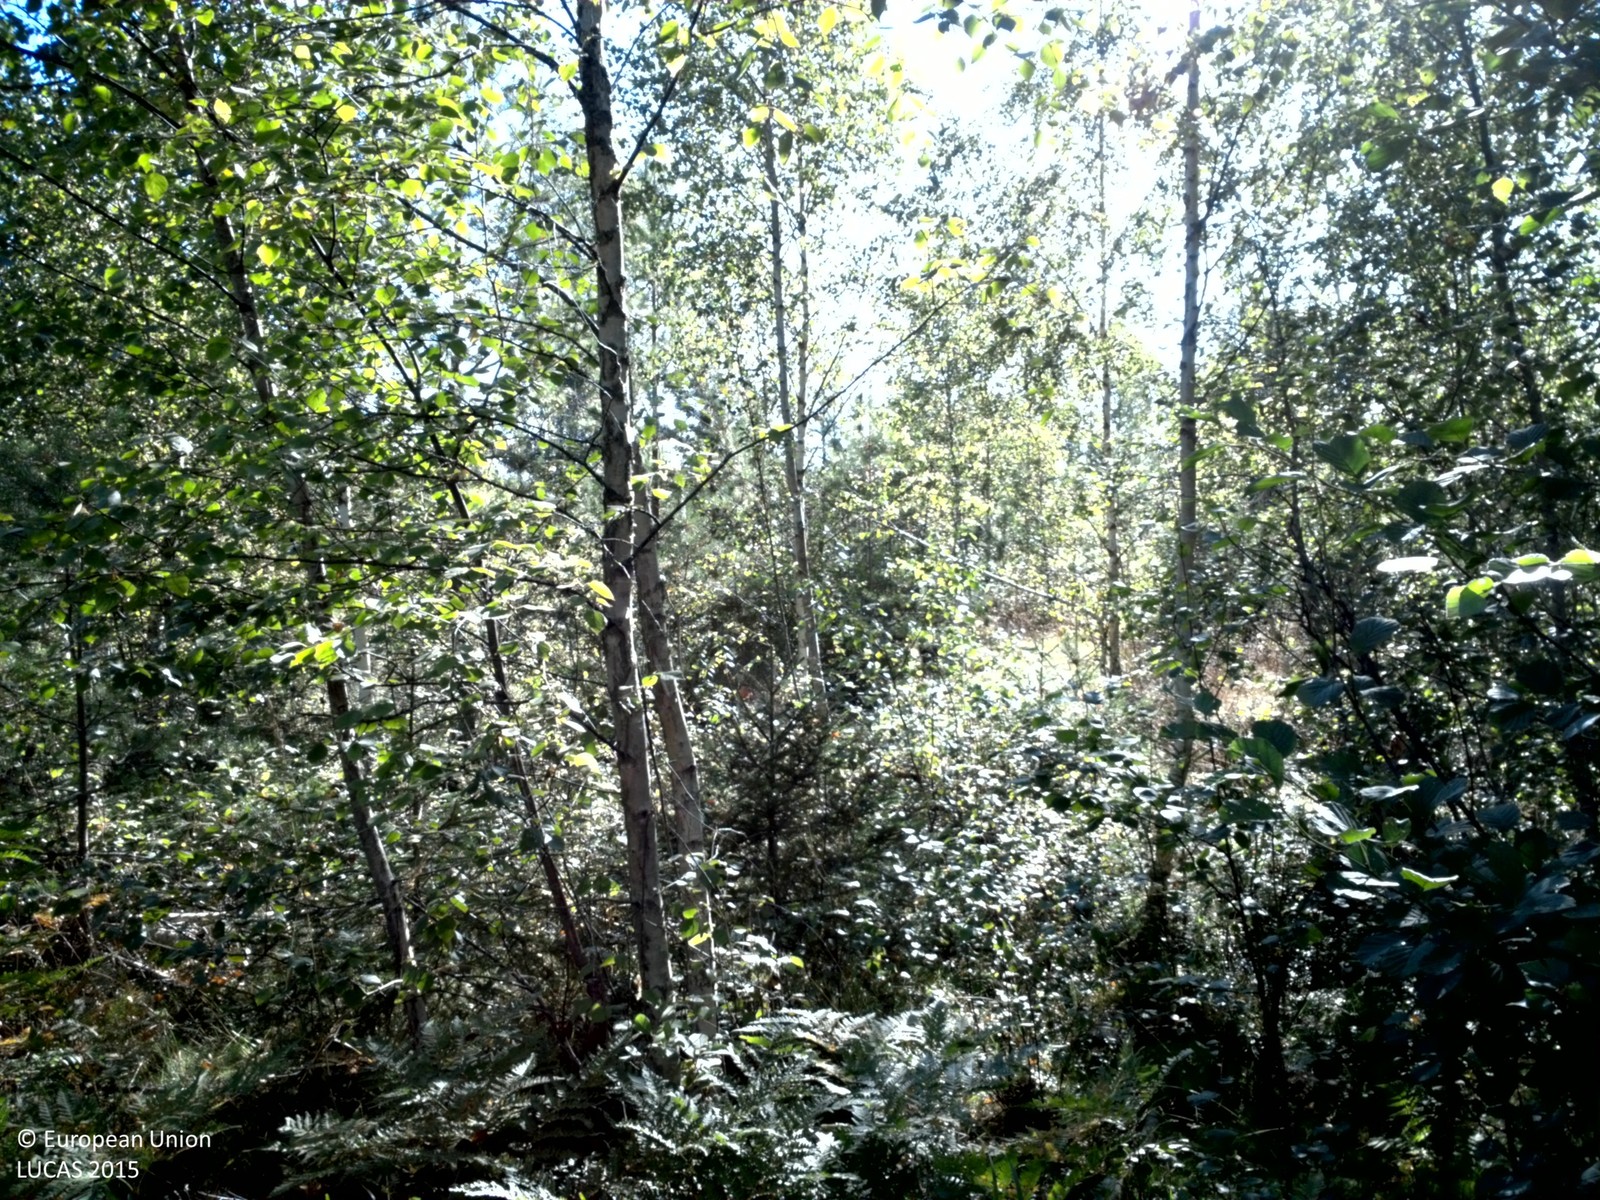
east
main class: Woodland
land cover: Pine dominated mixed woodland
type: boreal forest
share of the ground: 50 - 75 %
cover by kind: coniferous forest trees 30 %, herbaceous plants 30 %, broadleaved forest trees 25 %, shrubs 15 %
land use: Forestry
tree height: < 5 m
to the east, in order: Pine dominated mixed woodland; Grass margins; Tracks; Shruby margins; Pine dominated mixed woodland
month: August
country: SE
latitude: 60.0427
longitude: 18.0202
